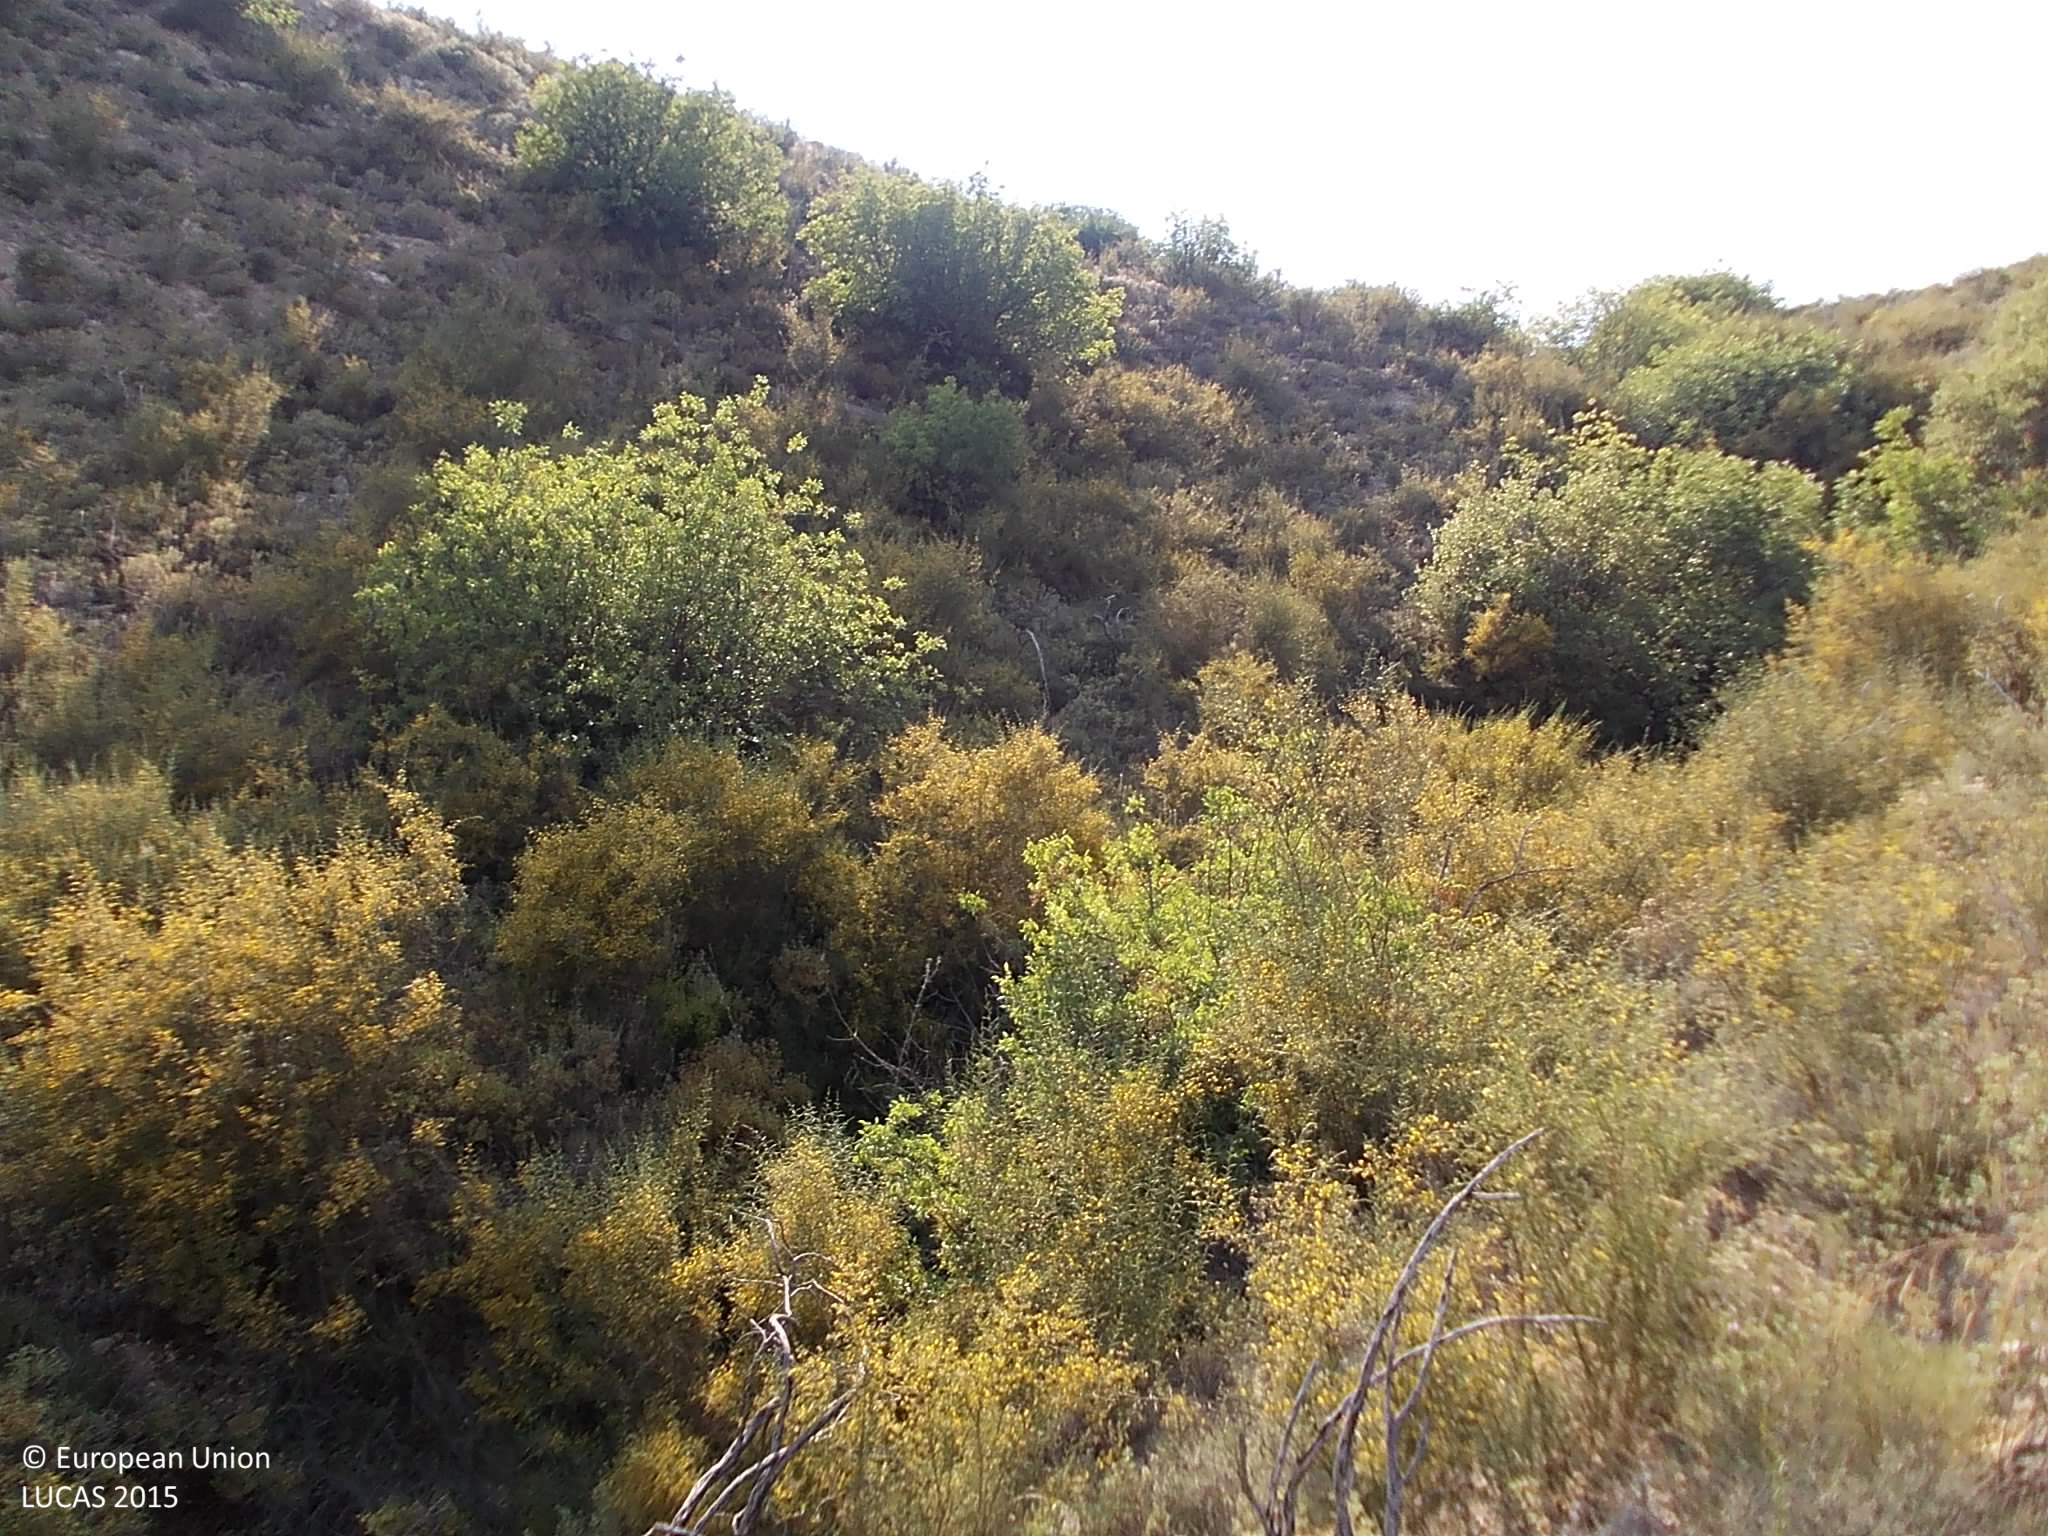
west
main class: Shrubland
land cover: Shrubland without tree cover
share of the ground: > 75 %
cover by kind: shrubs 80 %, herbaceous plants 10 %, unconsolidated bare surface 10 %
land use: Semi-natural and natural areas not in use
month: July
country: CY
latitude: 34.7664
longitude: 32.7397
